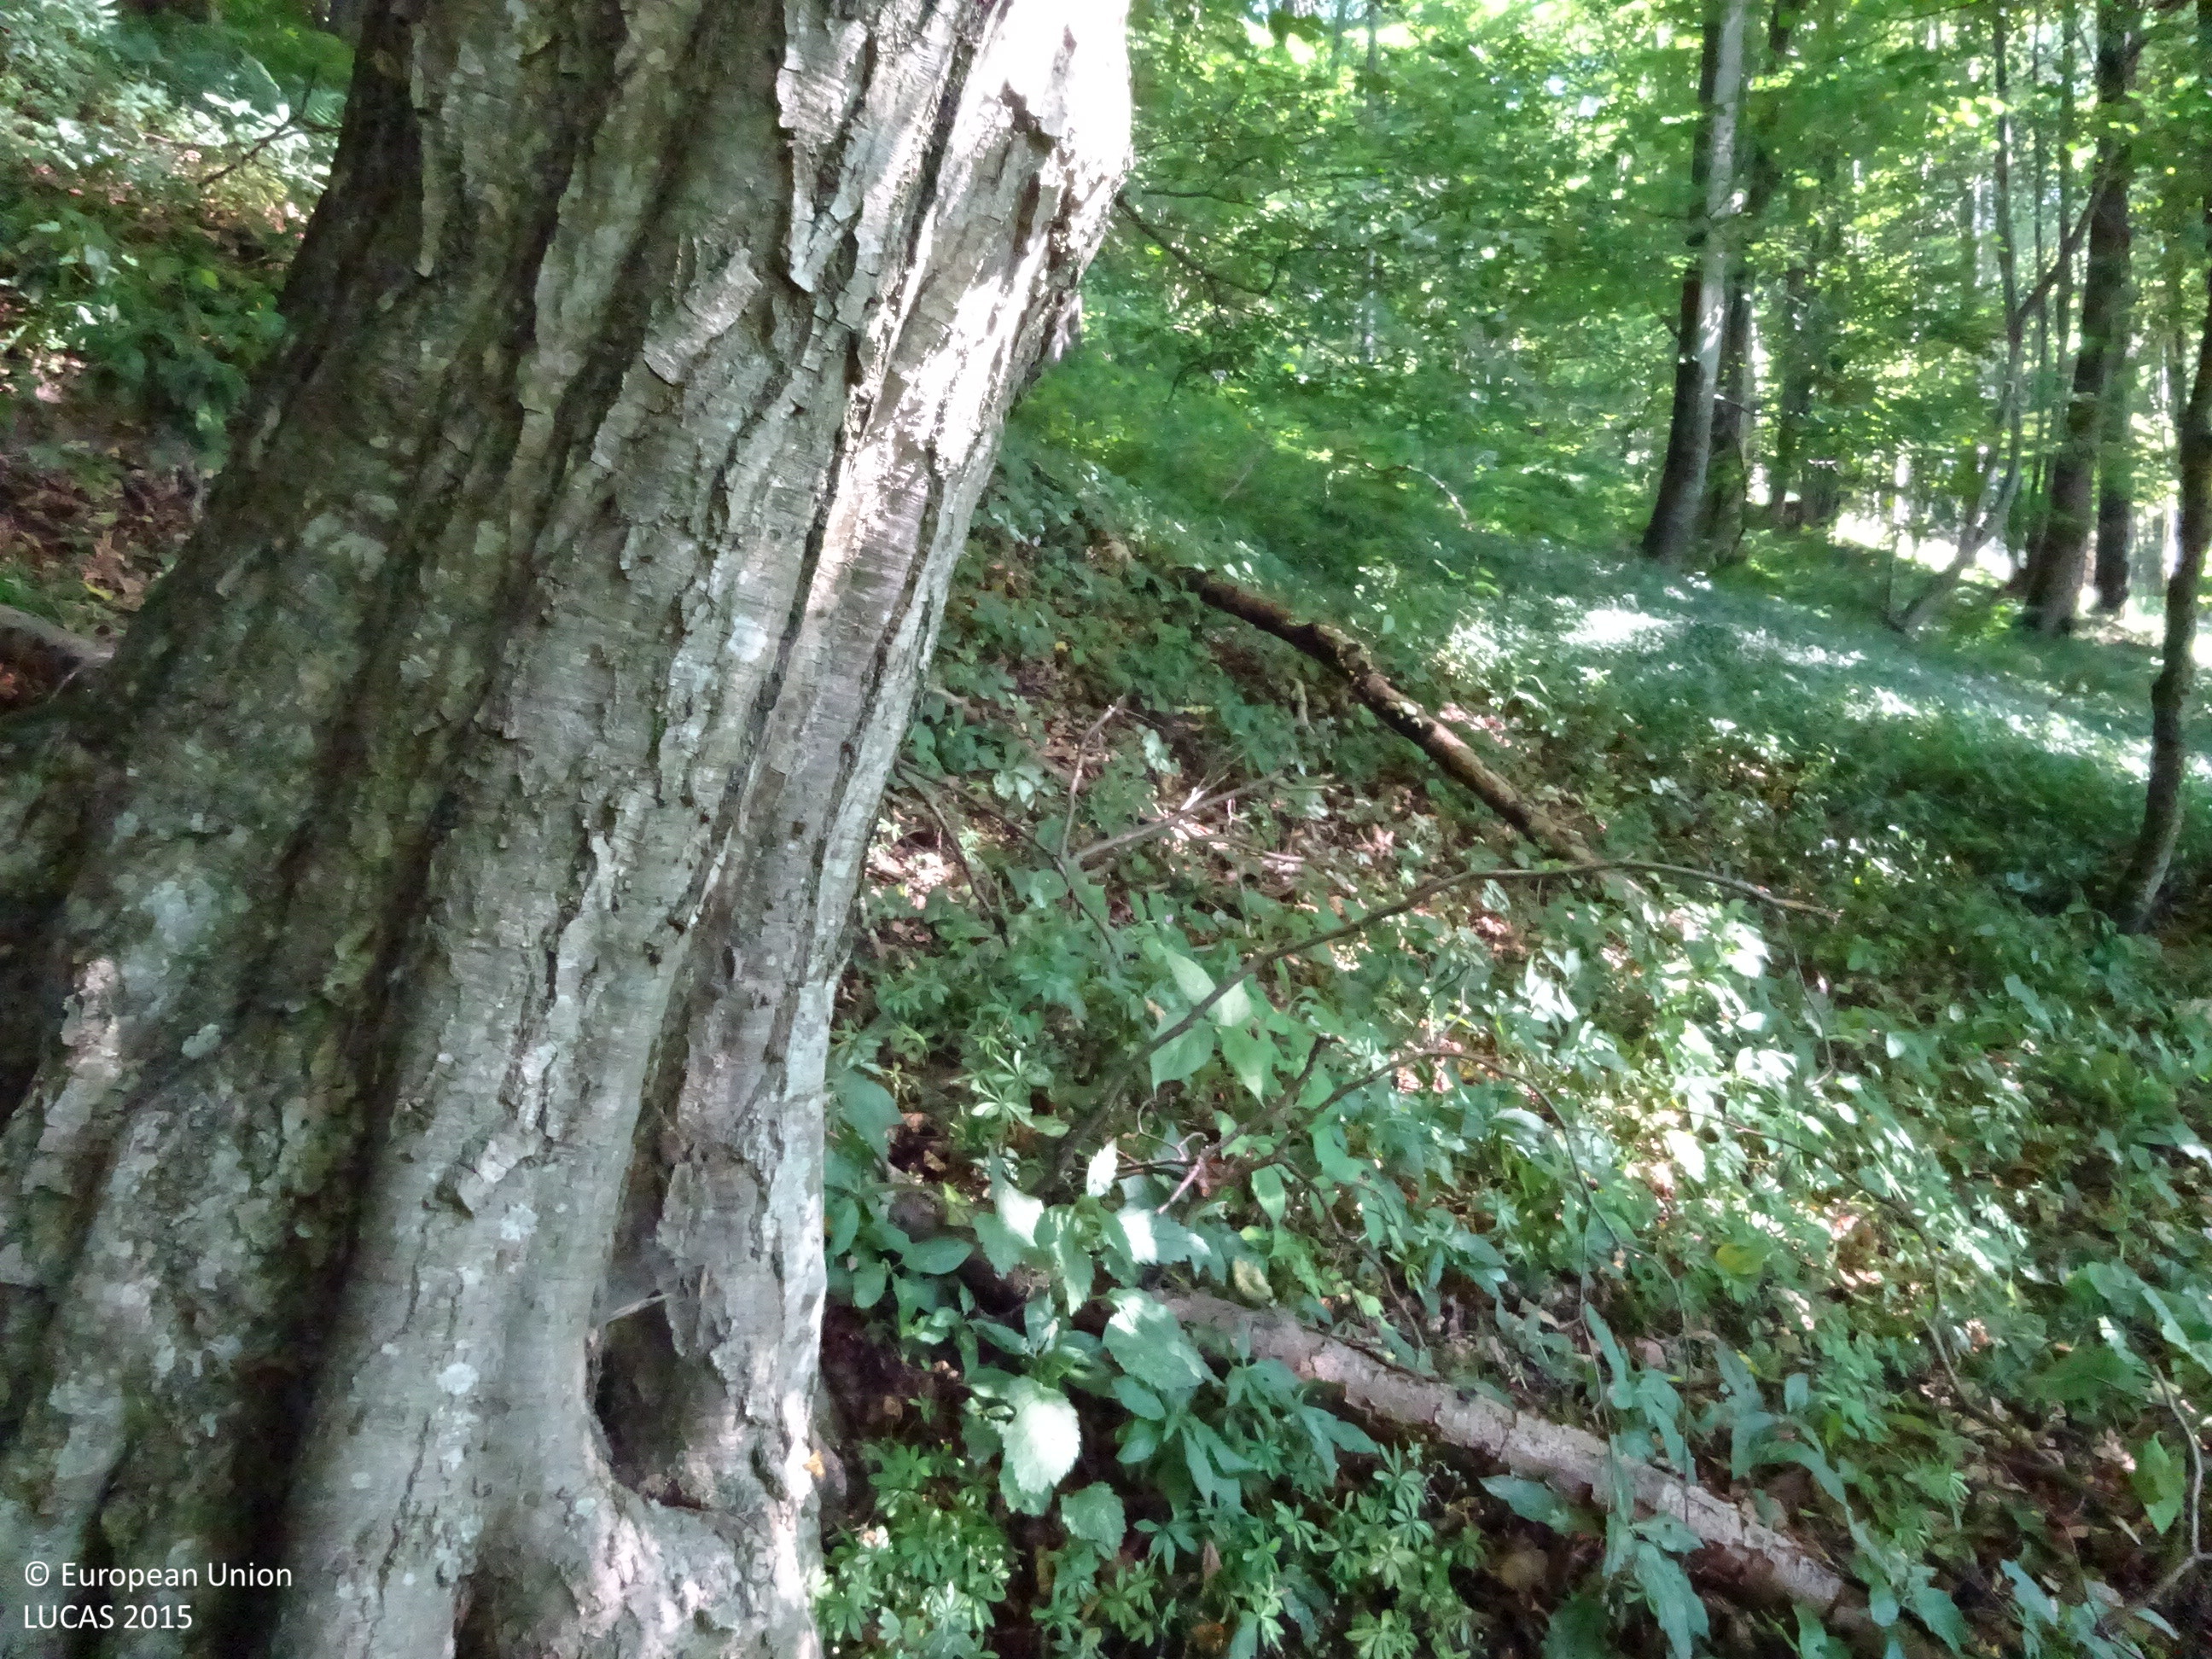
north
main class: Woodland
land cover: Broadleaved woodland
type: beech forest
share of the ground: > 75 %
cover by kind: broadleaved forest trees 100 %
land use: Forestry
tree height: > 5 m
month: August
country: AT
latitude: 47.4401
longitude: 16.1153
